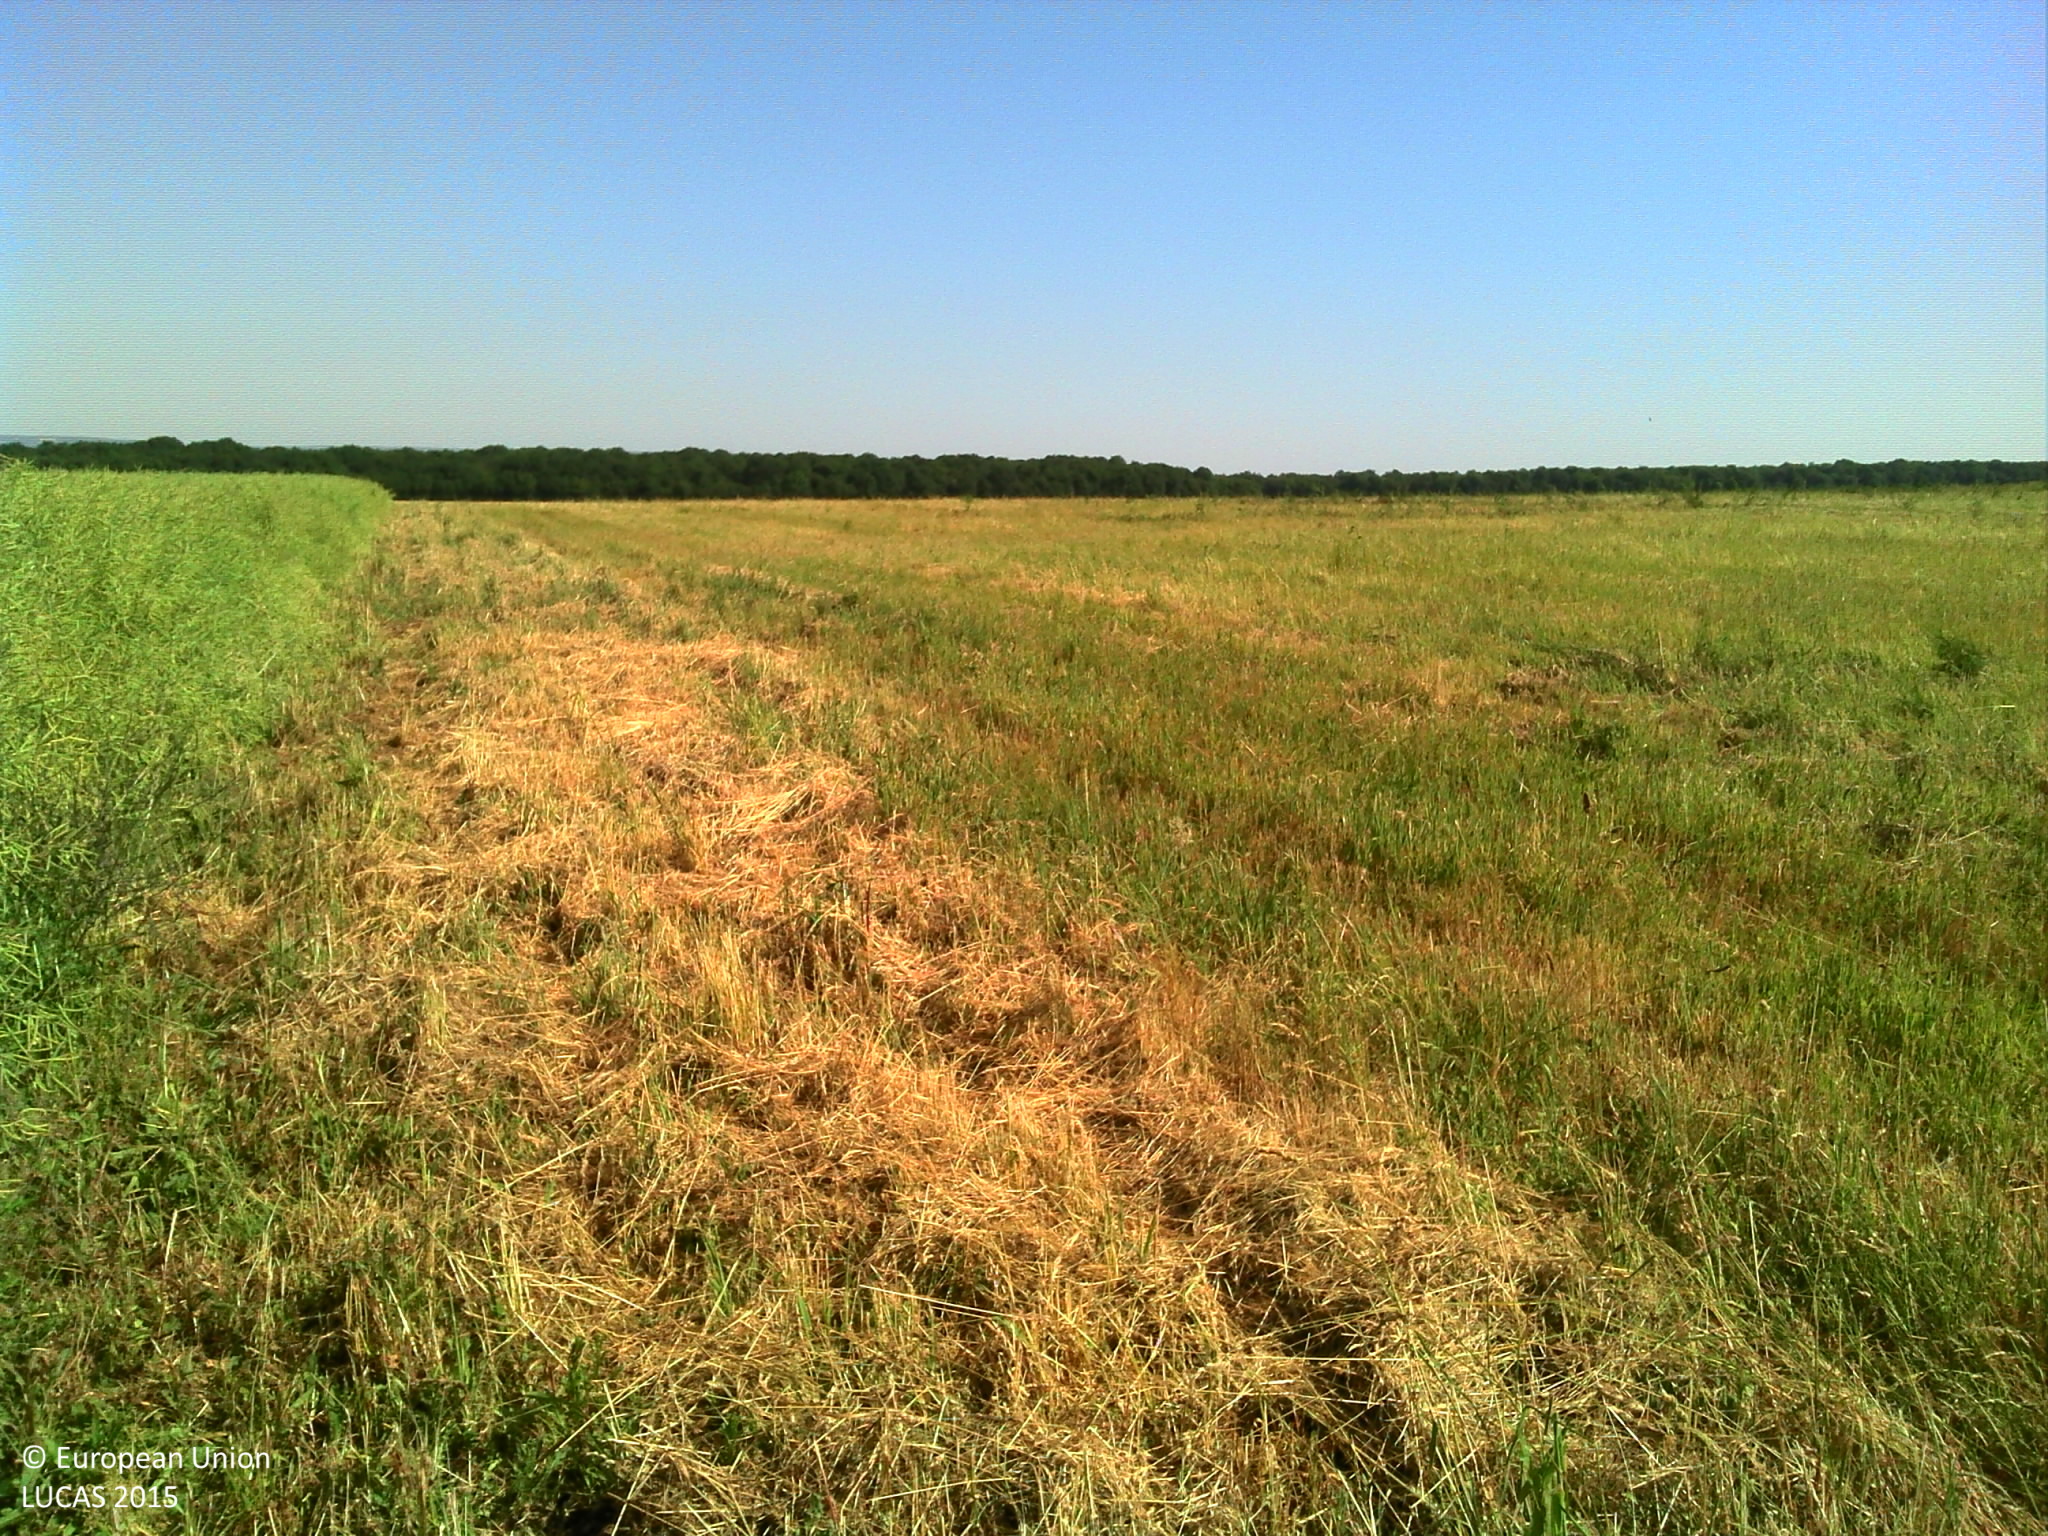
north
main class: Cropland
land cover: Rape and turnip rape
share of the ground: > 75 %
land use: Agriculture (excluding fallow land and kitchen gardens)
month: June
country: FR
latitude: 47.1108
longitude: 2.6535
